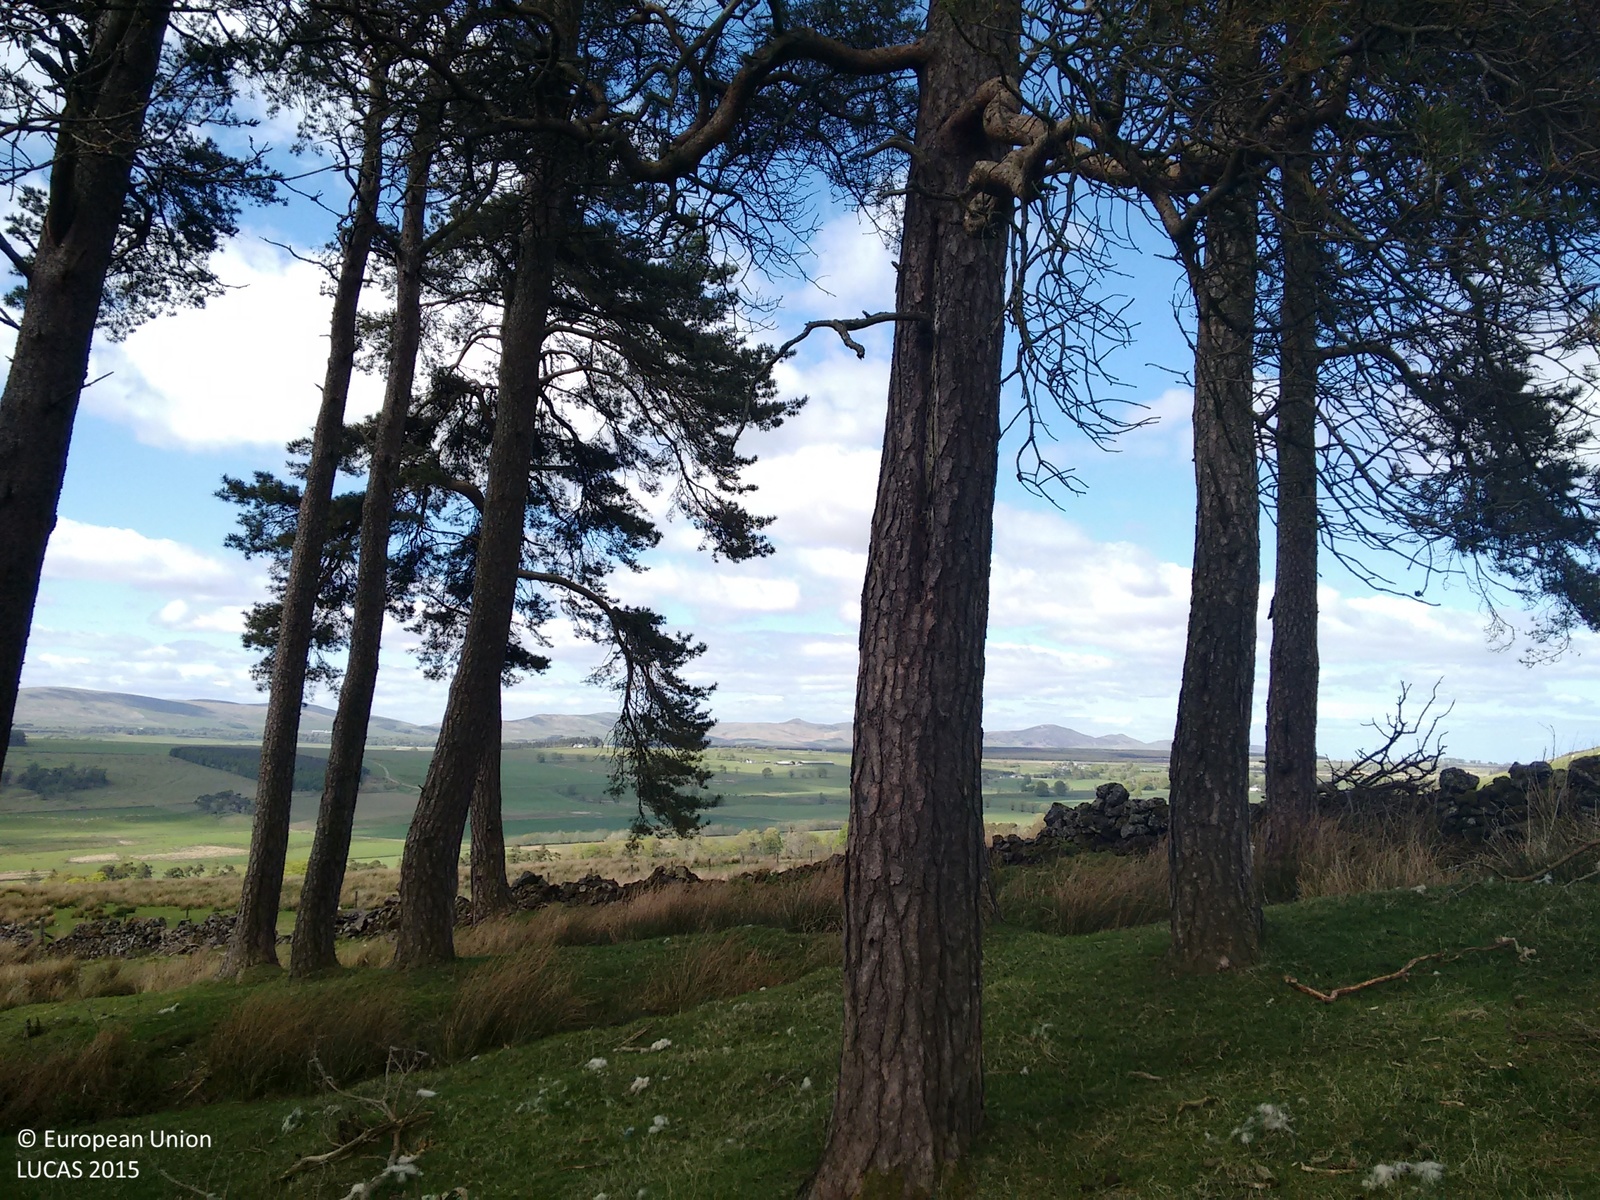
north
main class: Woodland
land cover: Pine dominated mixed woodland
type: hemiboreal forest and nemoral coniferous forest and mixed broadleaved-coniferous forest
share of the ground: > 75 %
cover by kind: coniferous forest trees 70 %, broadleaved forest trees 25 %, herbaceous plants 5 %
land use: Agriculture (excluding fallow land and kitchen gardens)
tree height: > 5 m
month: May
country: GB
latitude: 55.7279
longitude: -3.3064
